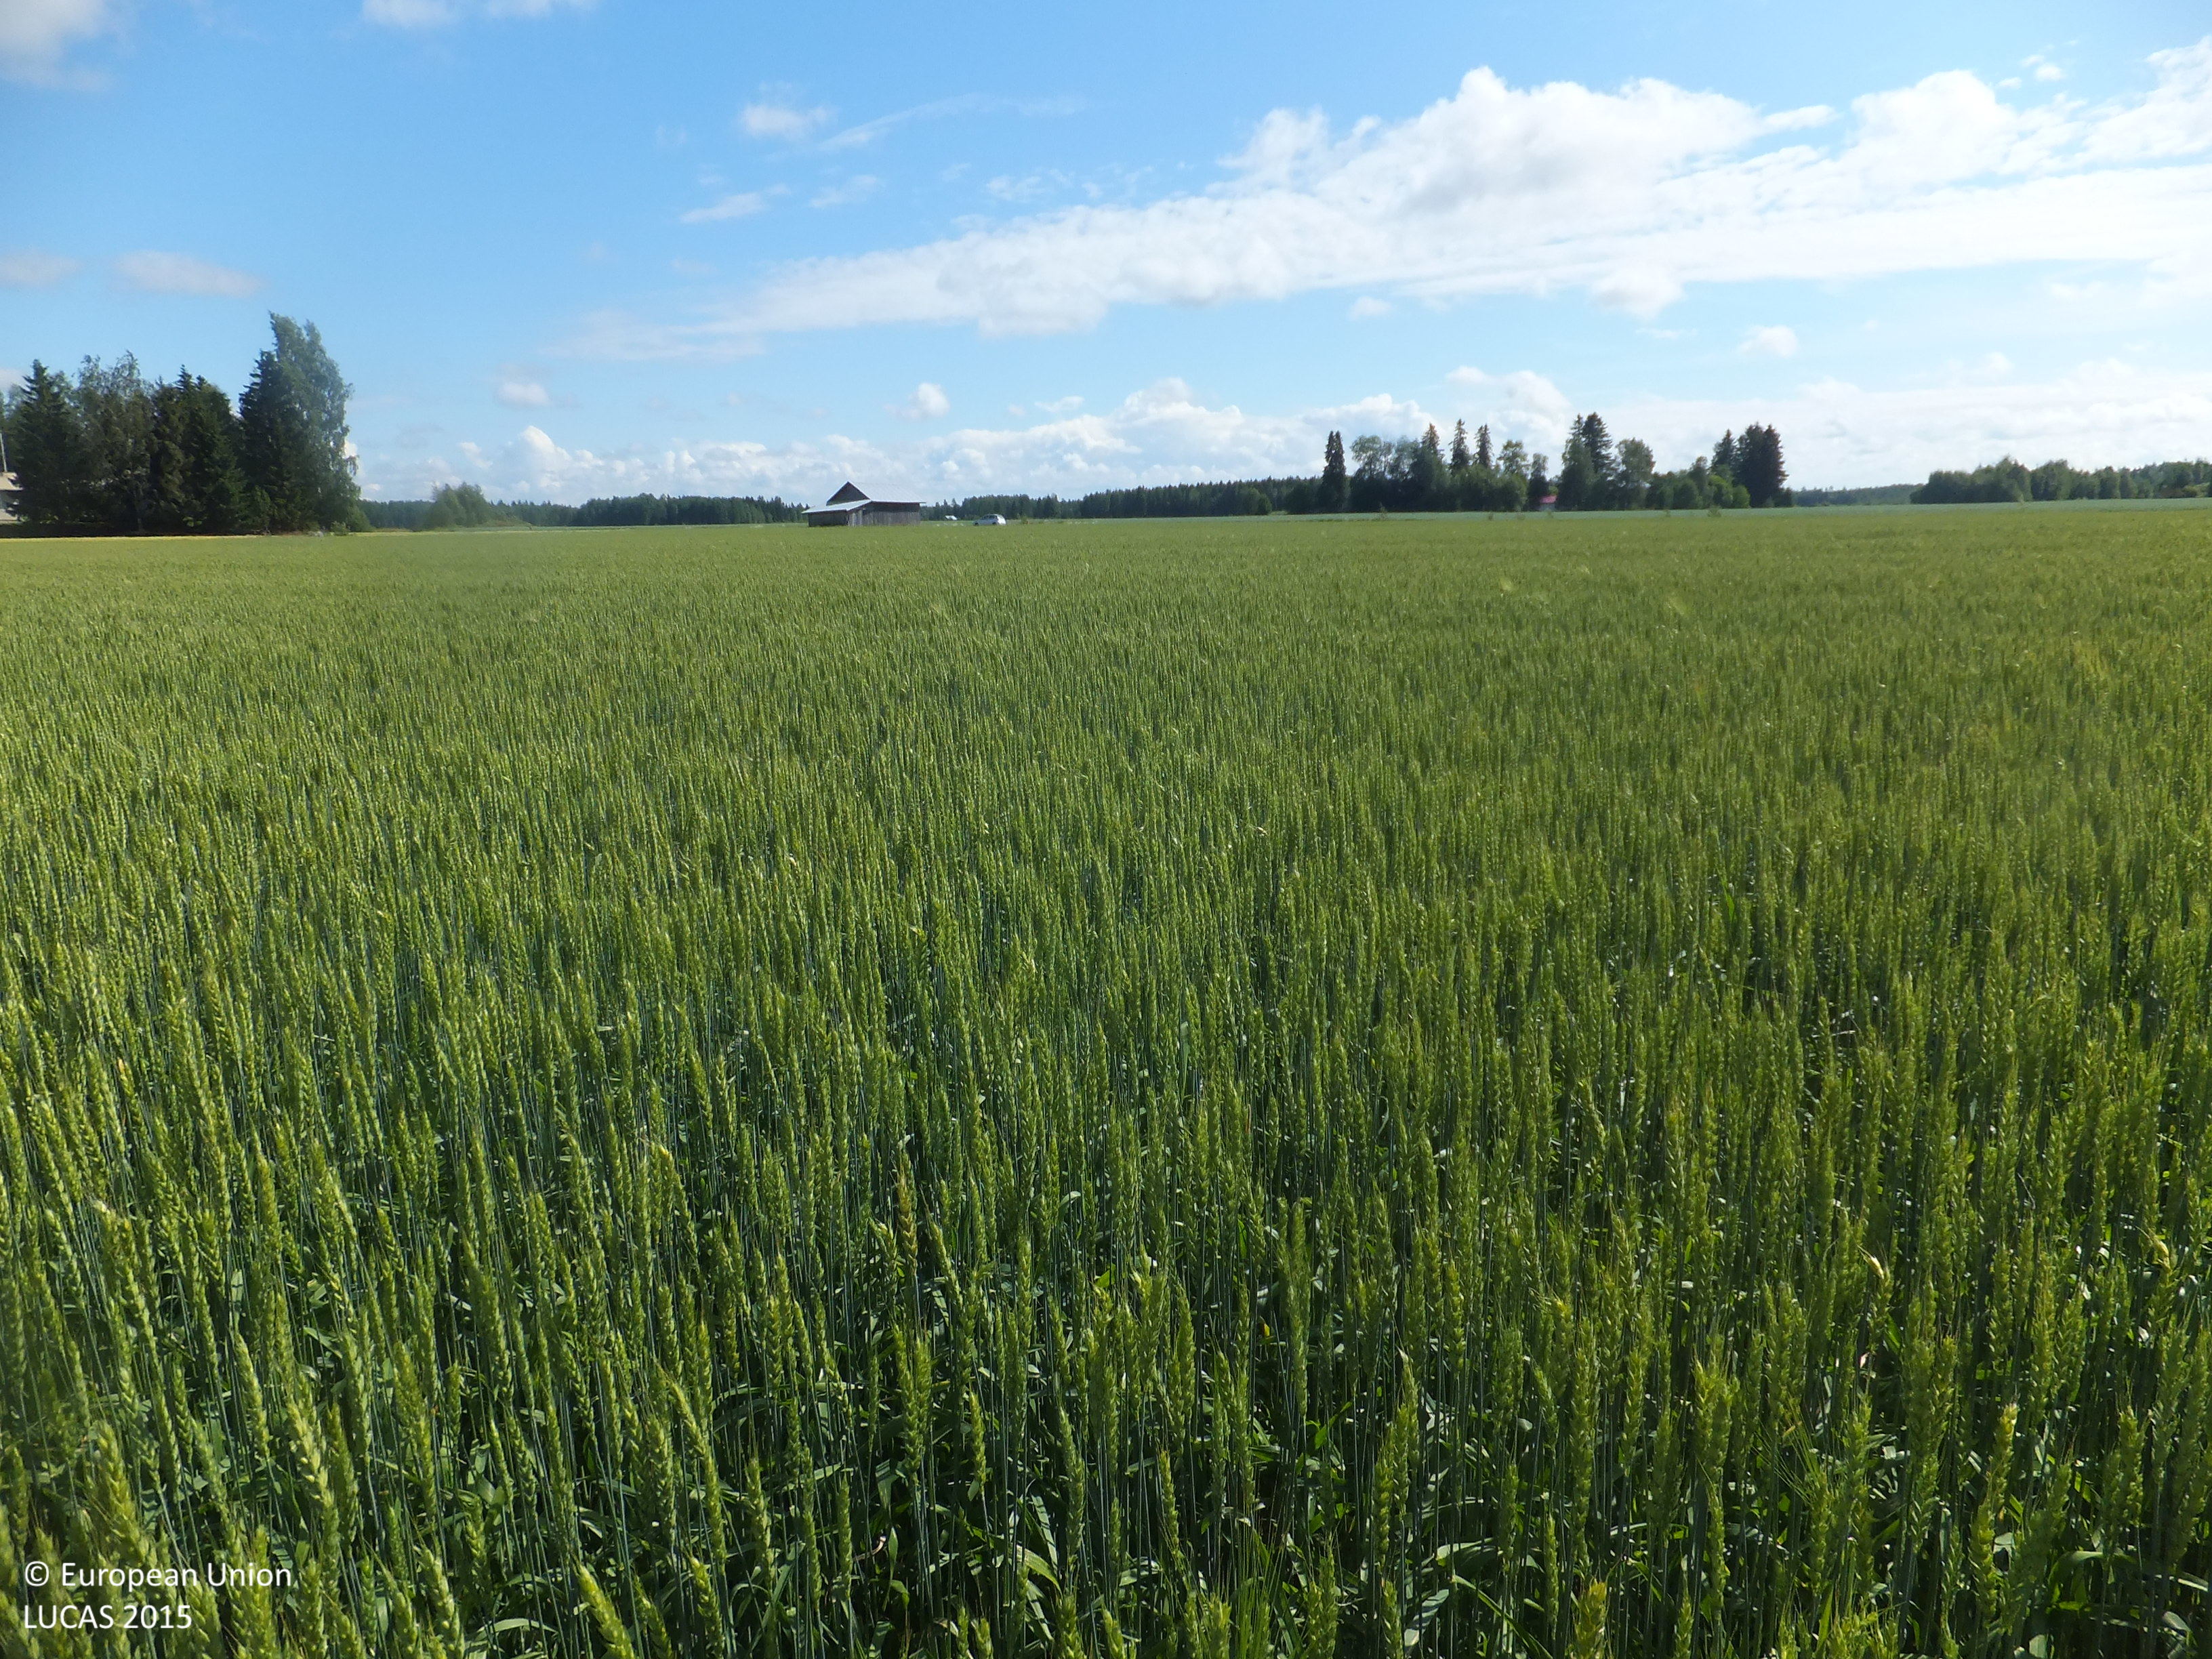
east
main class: Cropland
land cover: Common wheat
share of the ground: > 75 %
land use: Agriculture (excluding fallow land and kitchen gardens)
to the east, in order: Common wheat; Grass margins; Ditches and canals; Grass margins; Common wheat; Artificial constructions in urban areas; Common wheat; Grass margins; Ditches and canals; Paved roads, cycling and walking lanes; Ditches and canals; Oats
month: July
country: FI
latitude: 63.0285
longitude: 22.2017
